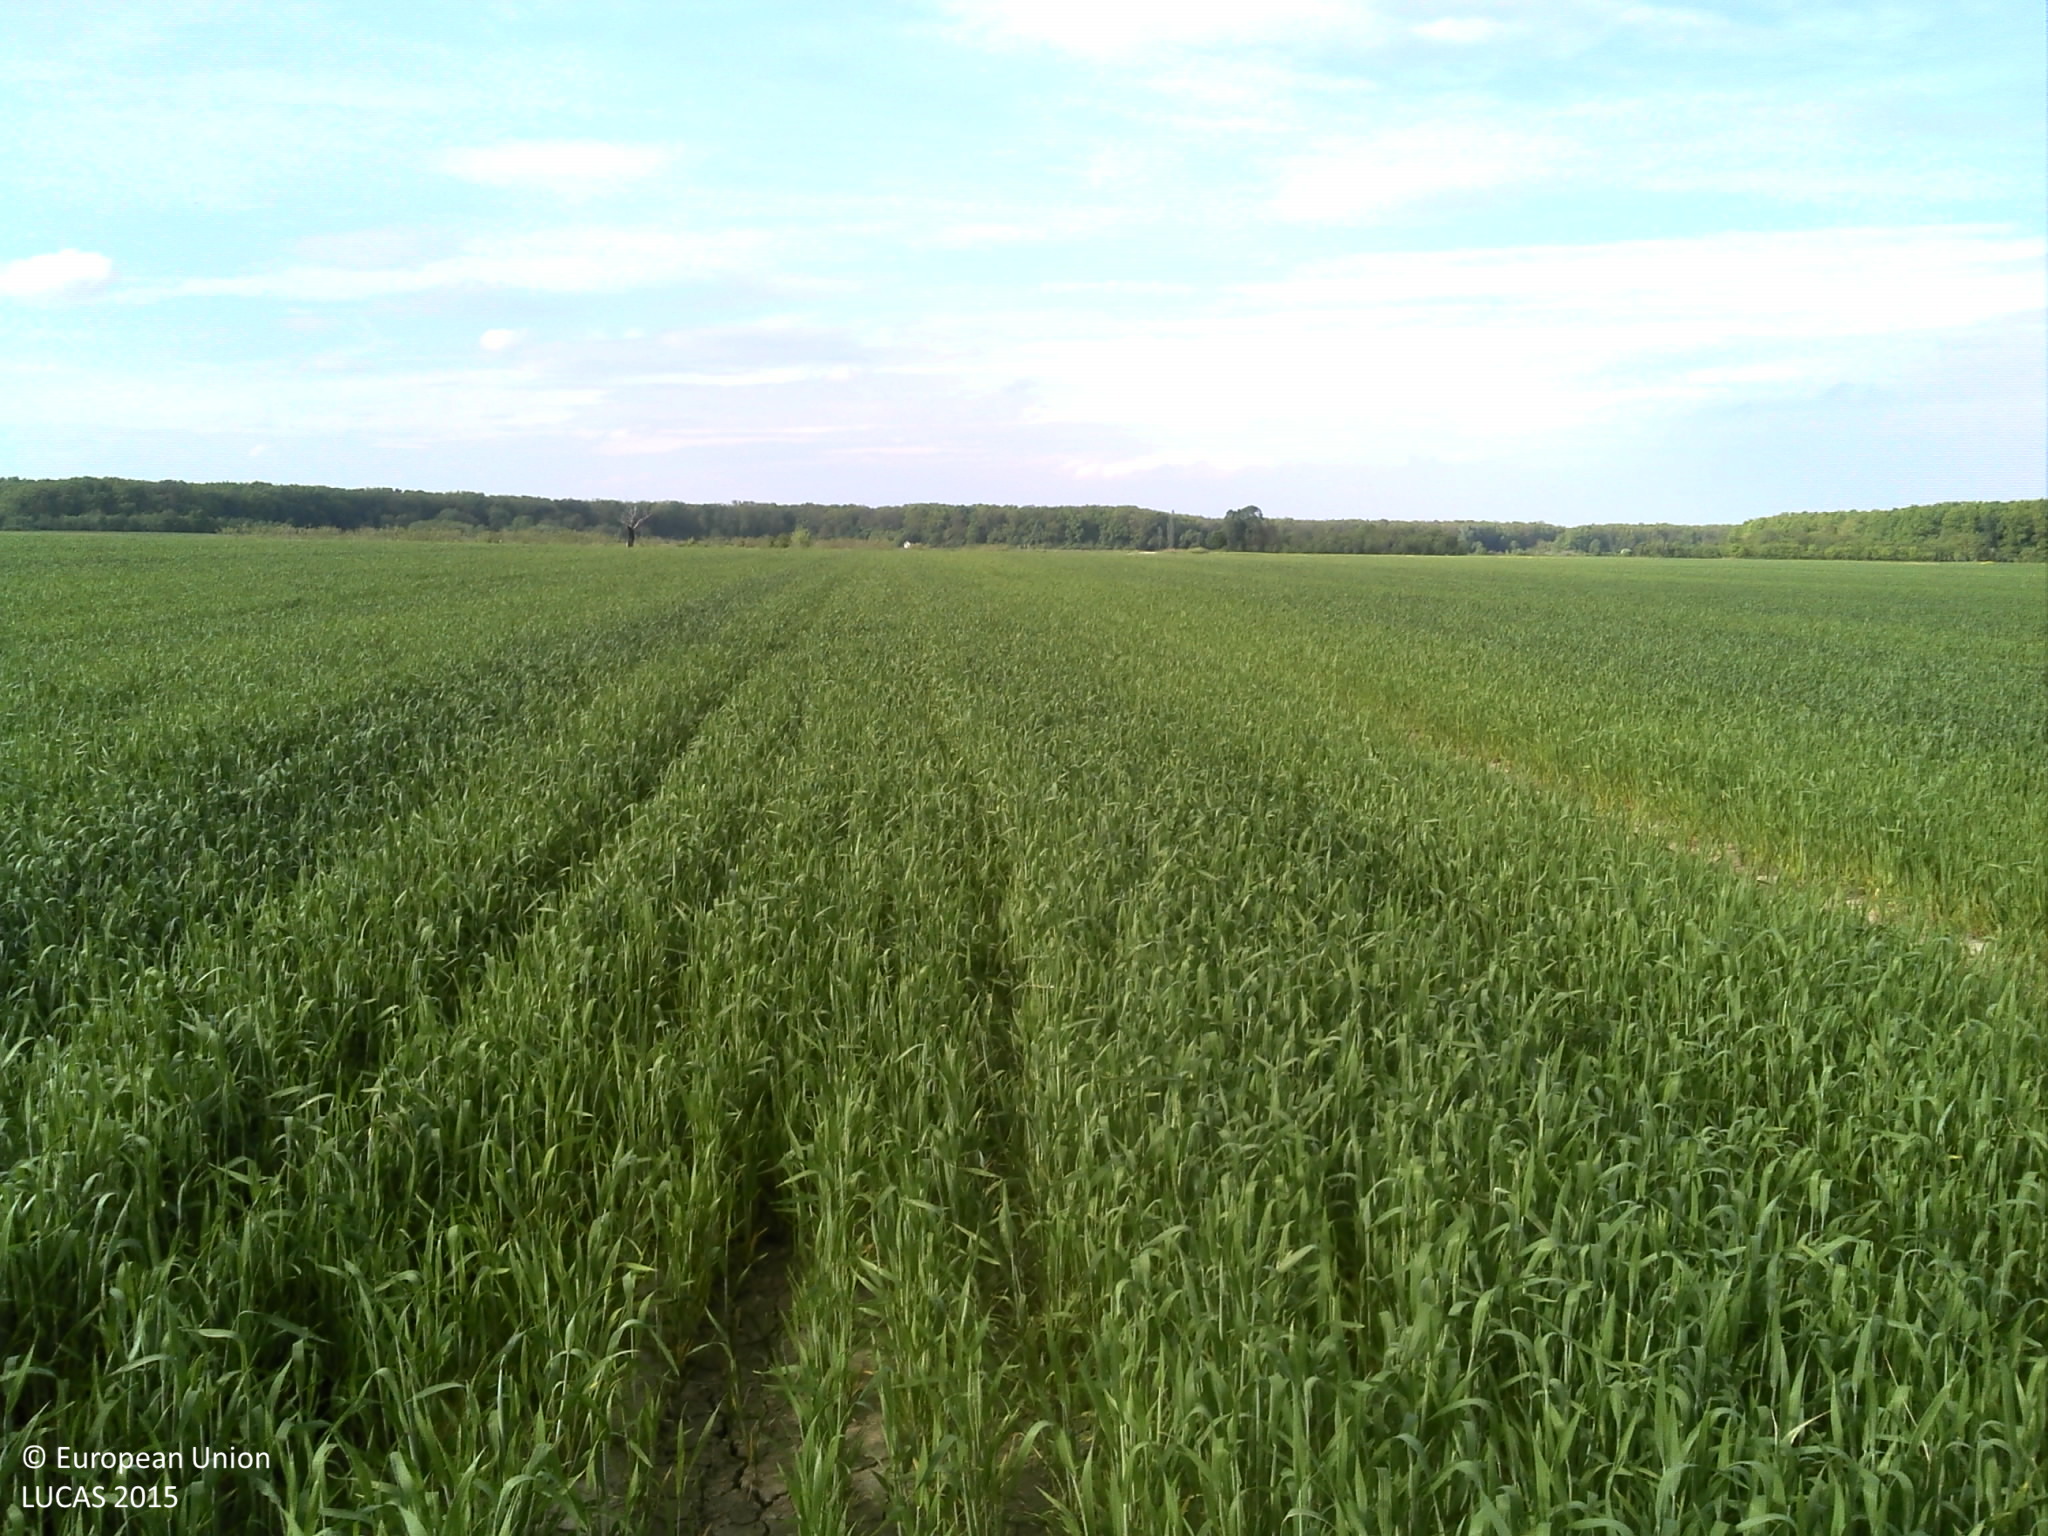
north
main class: Cropland
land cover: Common wheat
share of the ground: > 75 %
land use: Agriculture (excluding fallow land and kitchen gardens)
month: May
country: HR
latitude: 45.1642
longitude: 18.9001
